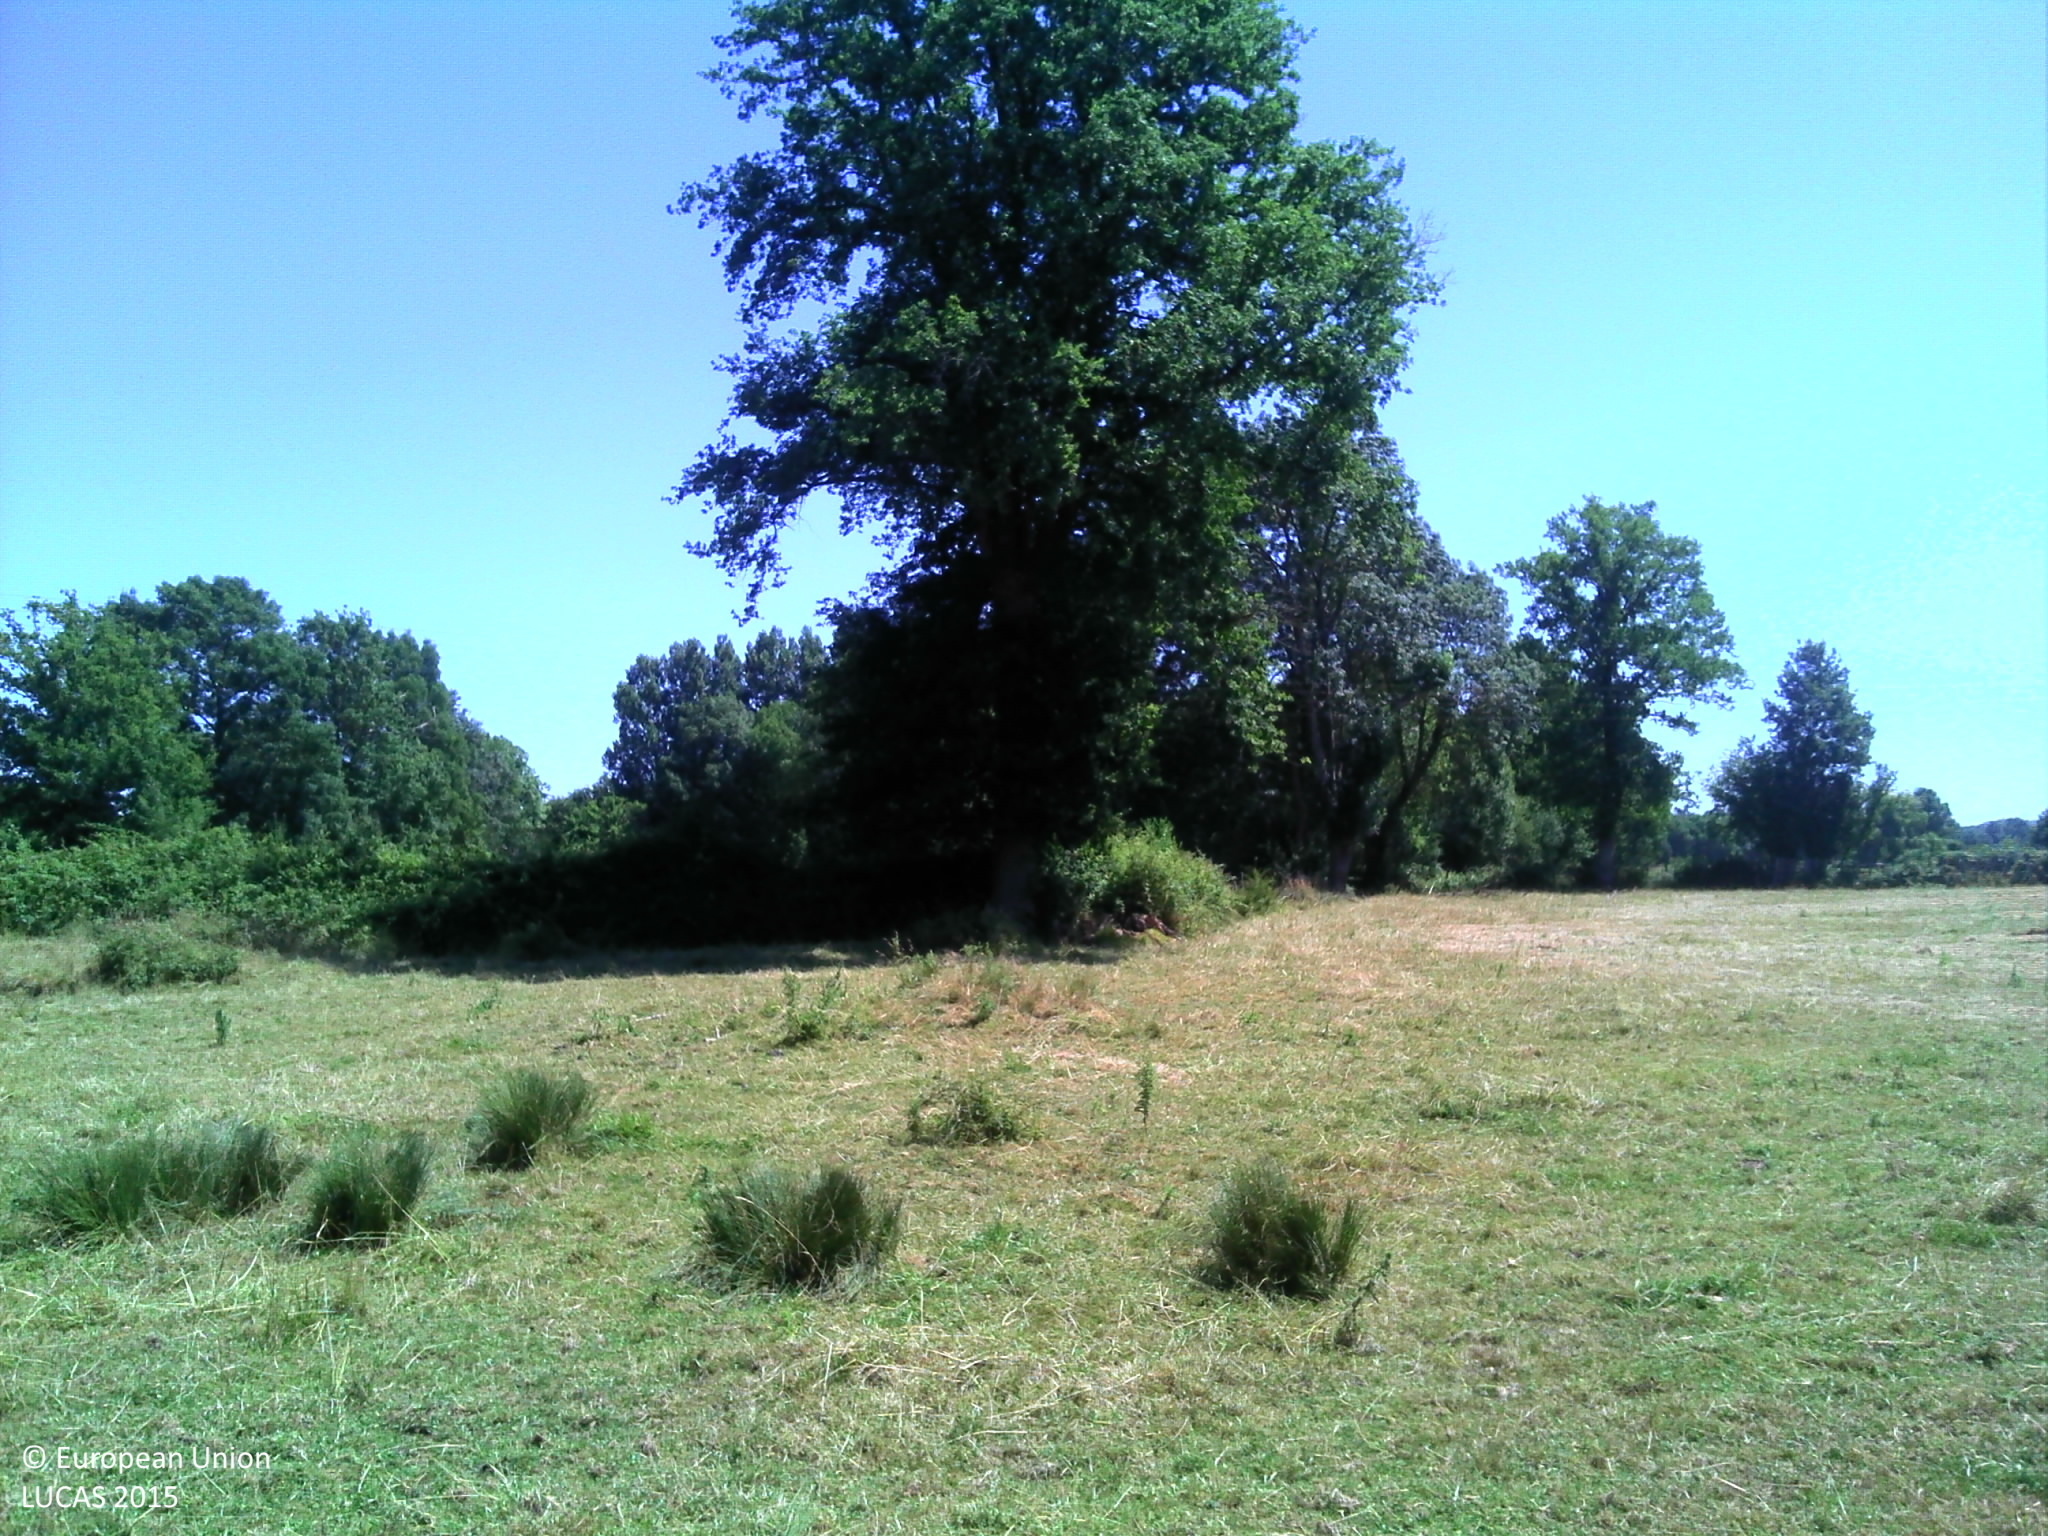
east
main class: Grassland
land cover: Grassland without tree/shrub cover
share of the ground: > 75 %
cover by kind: herbaceous plants 95 %, shrubs 5 %
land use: Agriculture (excluding fallow land and kitchen gardens)
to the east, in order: Grassland without tree/shrub cover; Fences; Abandoned hedges; Fences; Grassland without tree/shrub cover; Fences; Grassland without tree/shrub cover; Electric lines; Grassland without tree/shrub cover
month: July
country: FR
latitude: 47.6675
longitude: 0.2943
